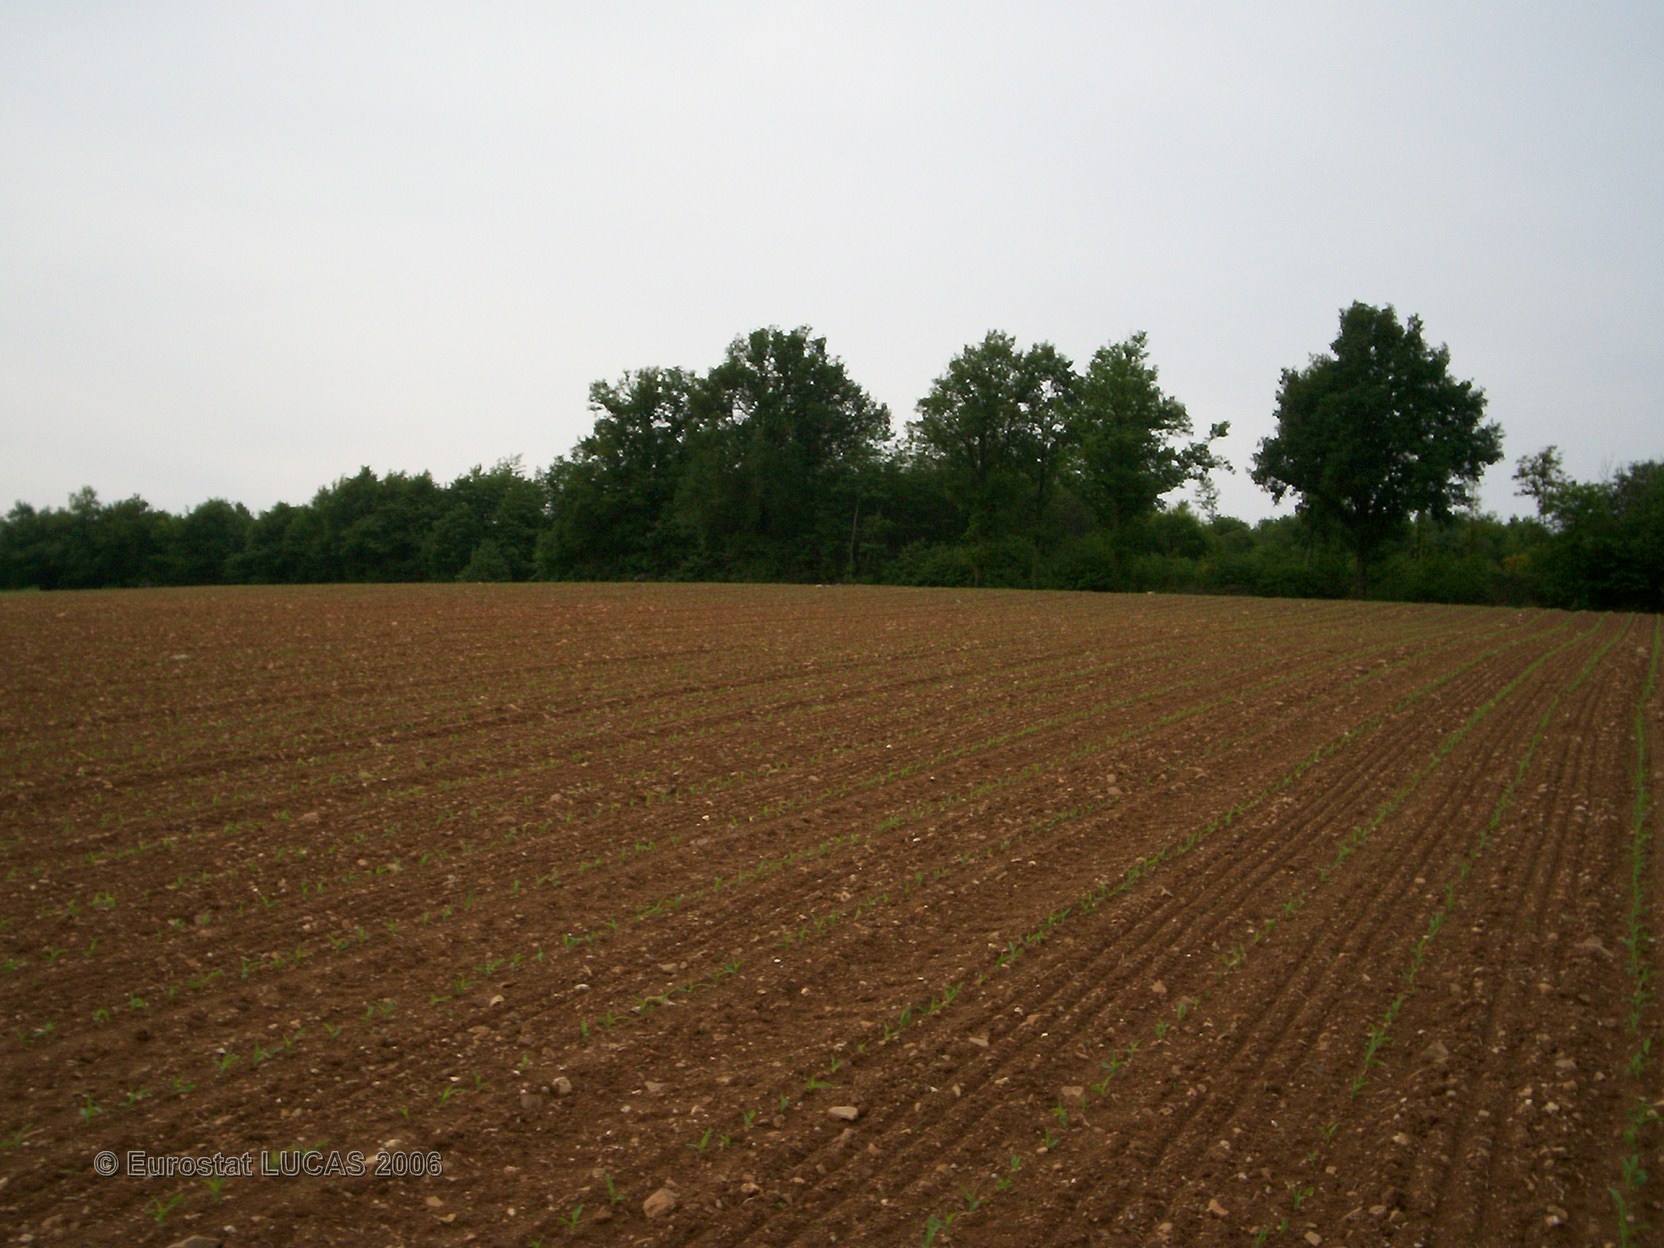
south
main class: Cropland
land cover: Maize
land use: Agriculture (excluding fallow land and kitchen gardens)
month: May
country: FR
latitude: 46.6731
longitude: -0.8149
